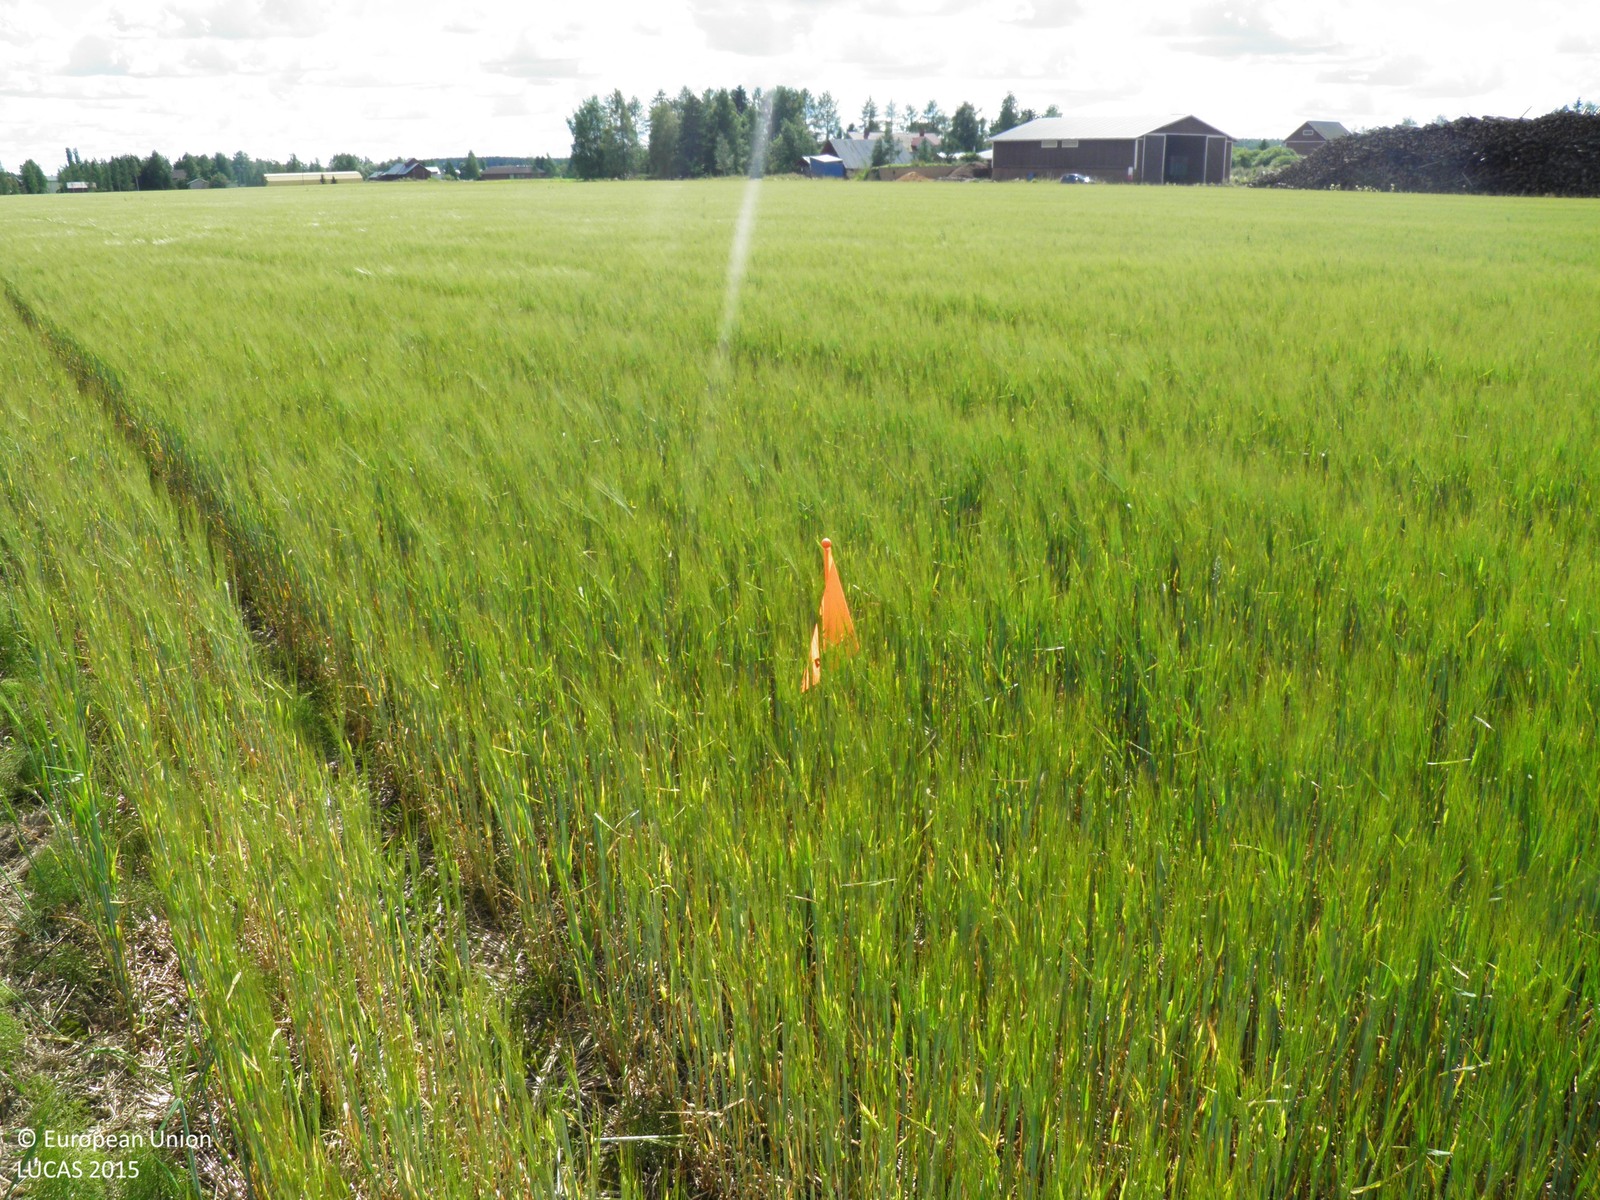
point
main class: Cropland
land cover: Barley
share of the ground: > 75 %
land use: Agriculture (excluding fallow land and kitchen gardens)
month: August
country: FI
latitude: 60.9492
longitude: 22.9792
